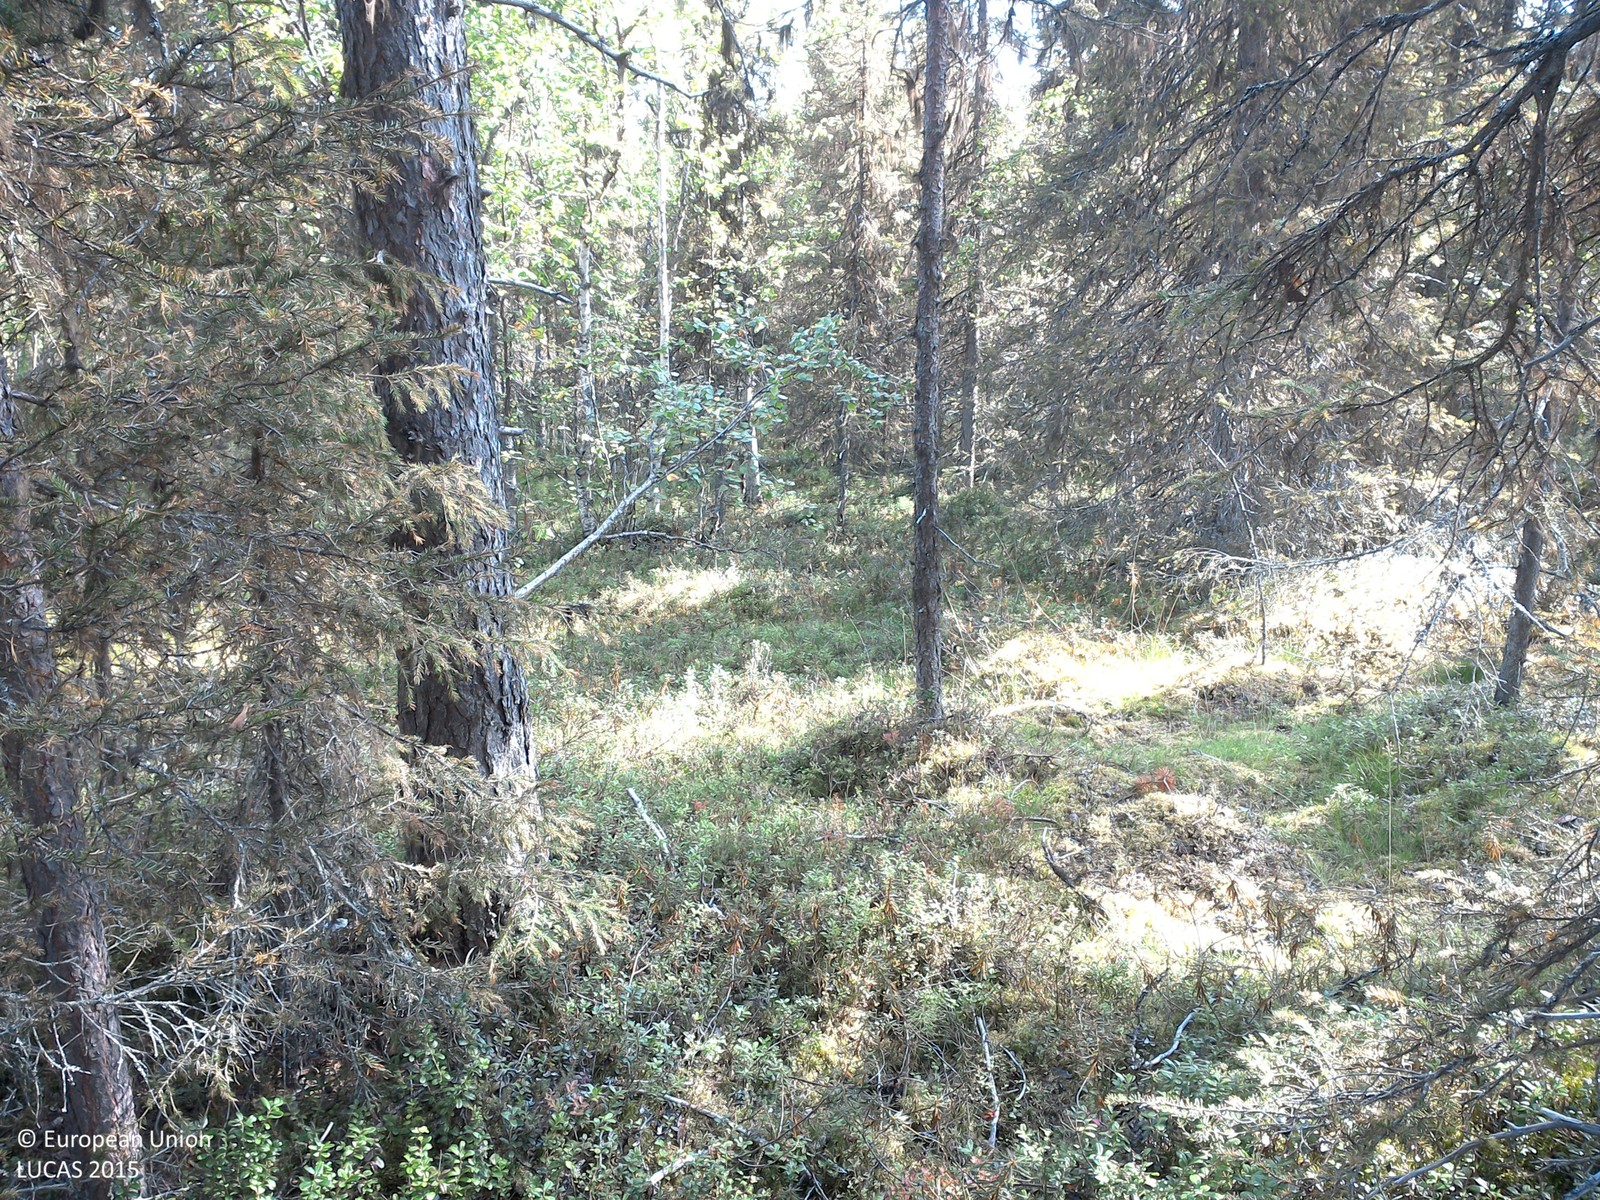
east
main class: Woodland
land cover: Spruce dominated mixed woodland
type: boreal forest
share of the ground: 25 - 50 %
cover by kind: shrubs 55 %, coniferous forest trees 25 %, broadleaved forest trees 10 %, lichens and mosses 10 %
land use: Forestry
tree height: > 5 m
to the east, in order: Spruce dominated mixed woodland; Broadleaved woodland
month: August
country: SE
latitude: 67.3556
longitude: 22.2232
